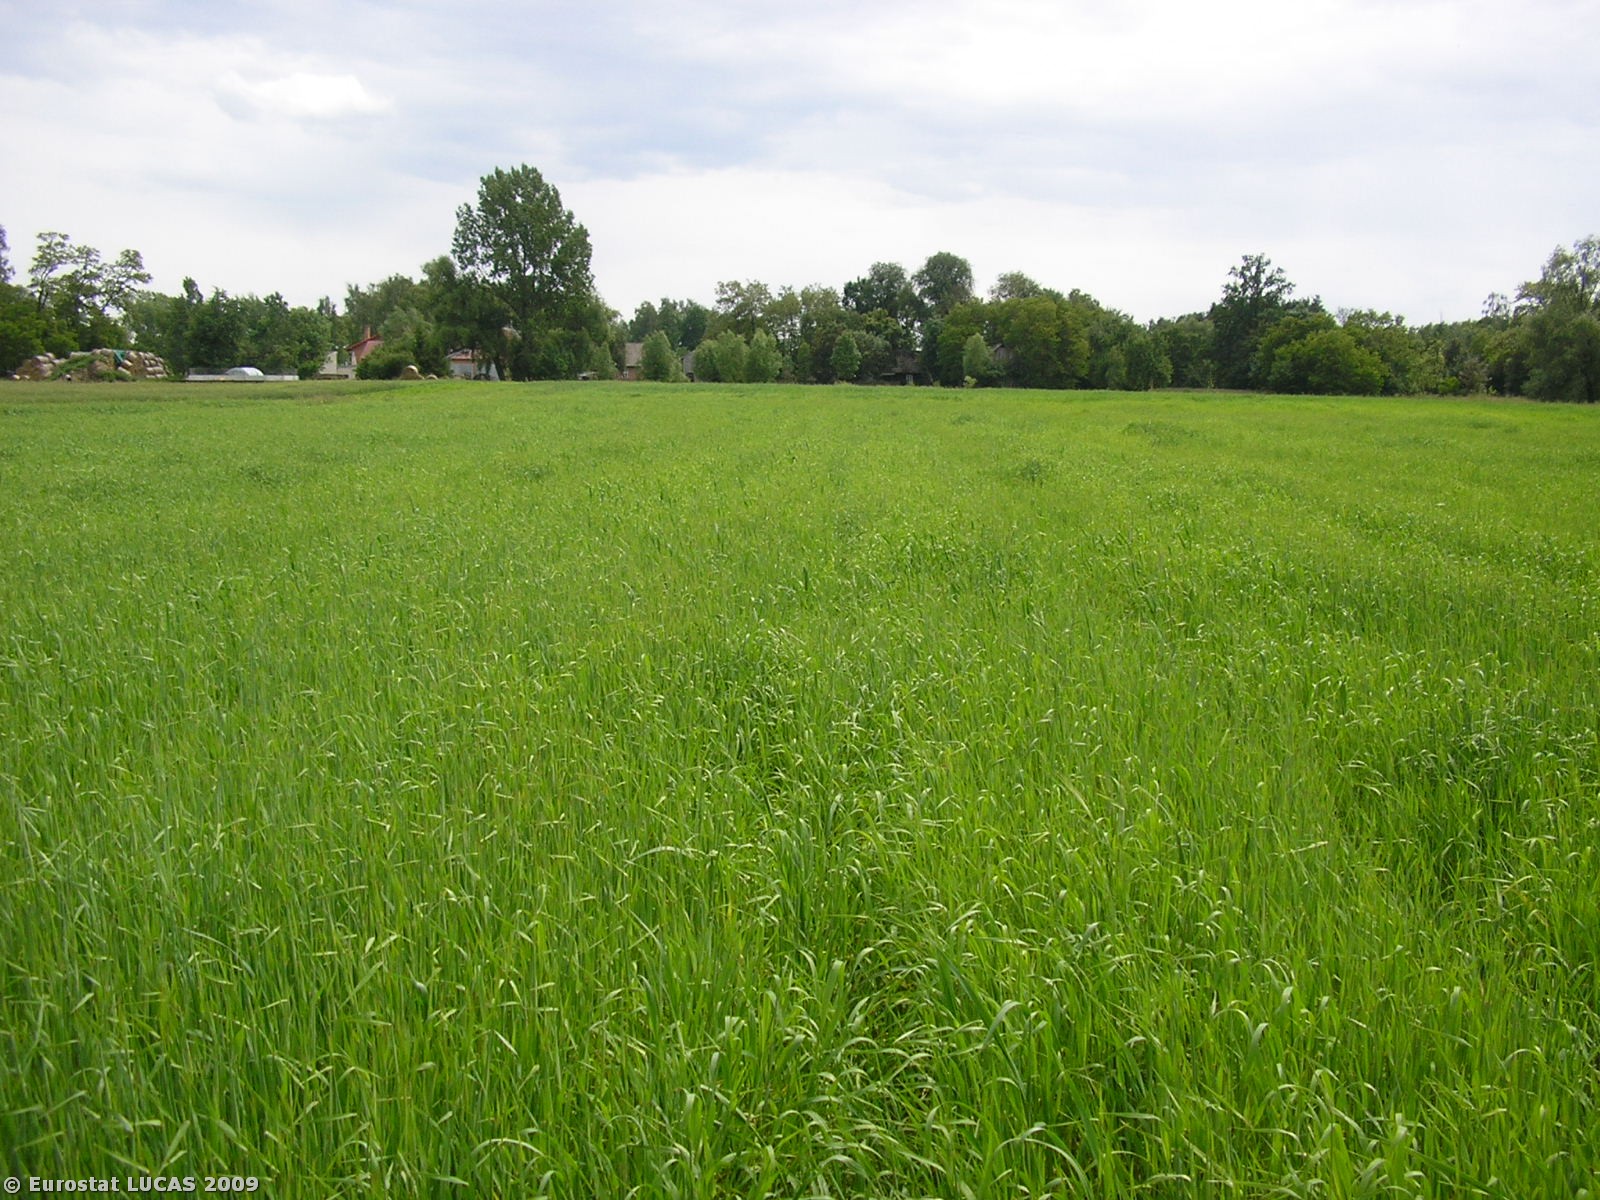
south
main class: Cropland
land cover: Barley
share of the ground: > 75 %
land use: Agriculture (excluding fallow land and kitchen gardens)
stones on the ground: 10 - 25 %
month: June
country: PL
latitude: 51.2988
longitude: 18.9293
